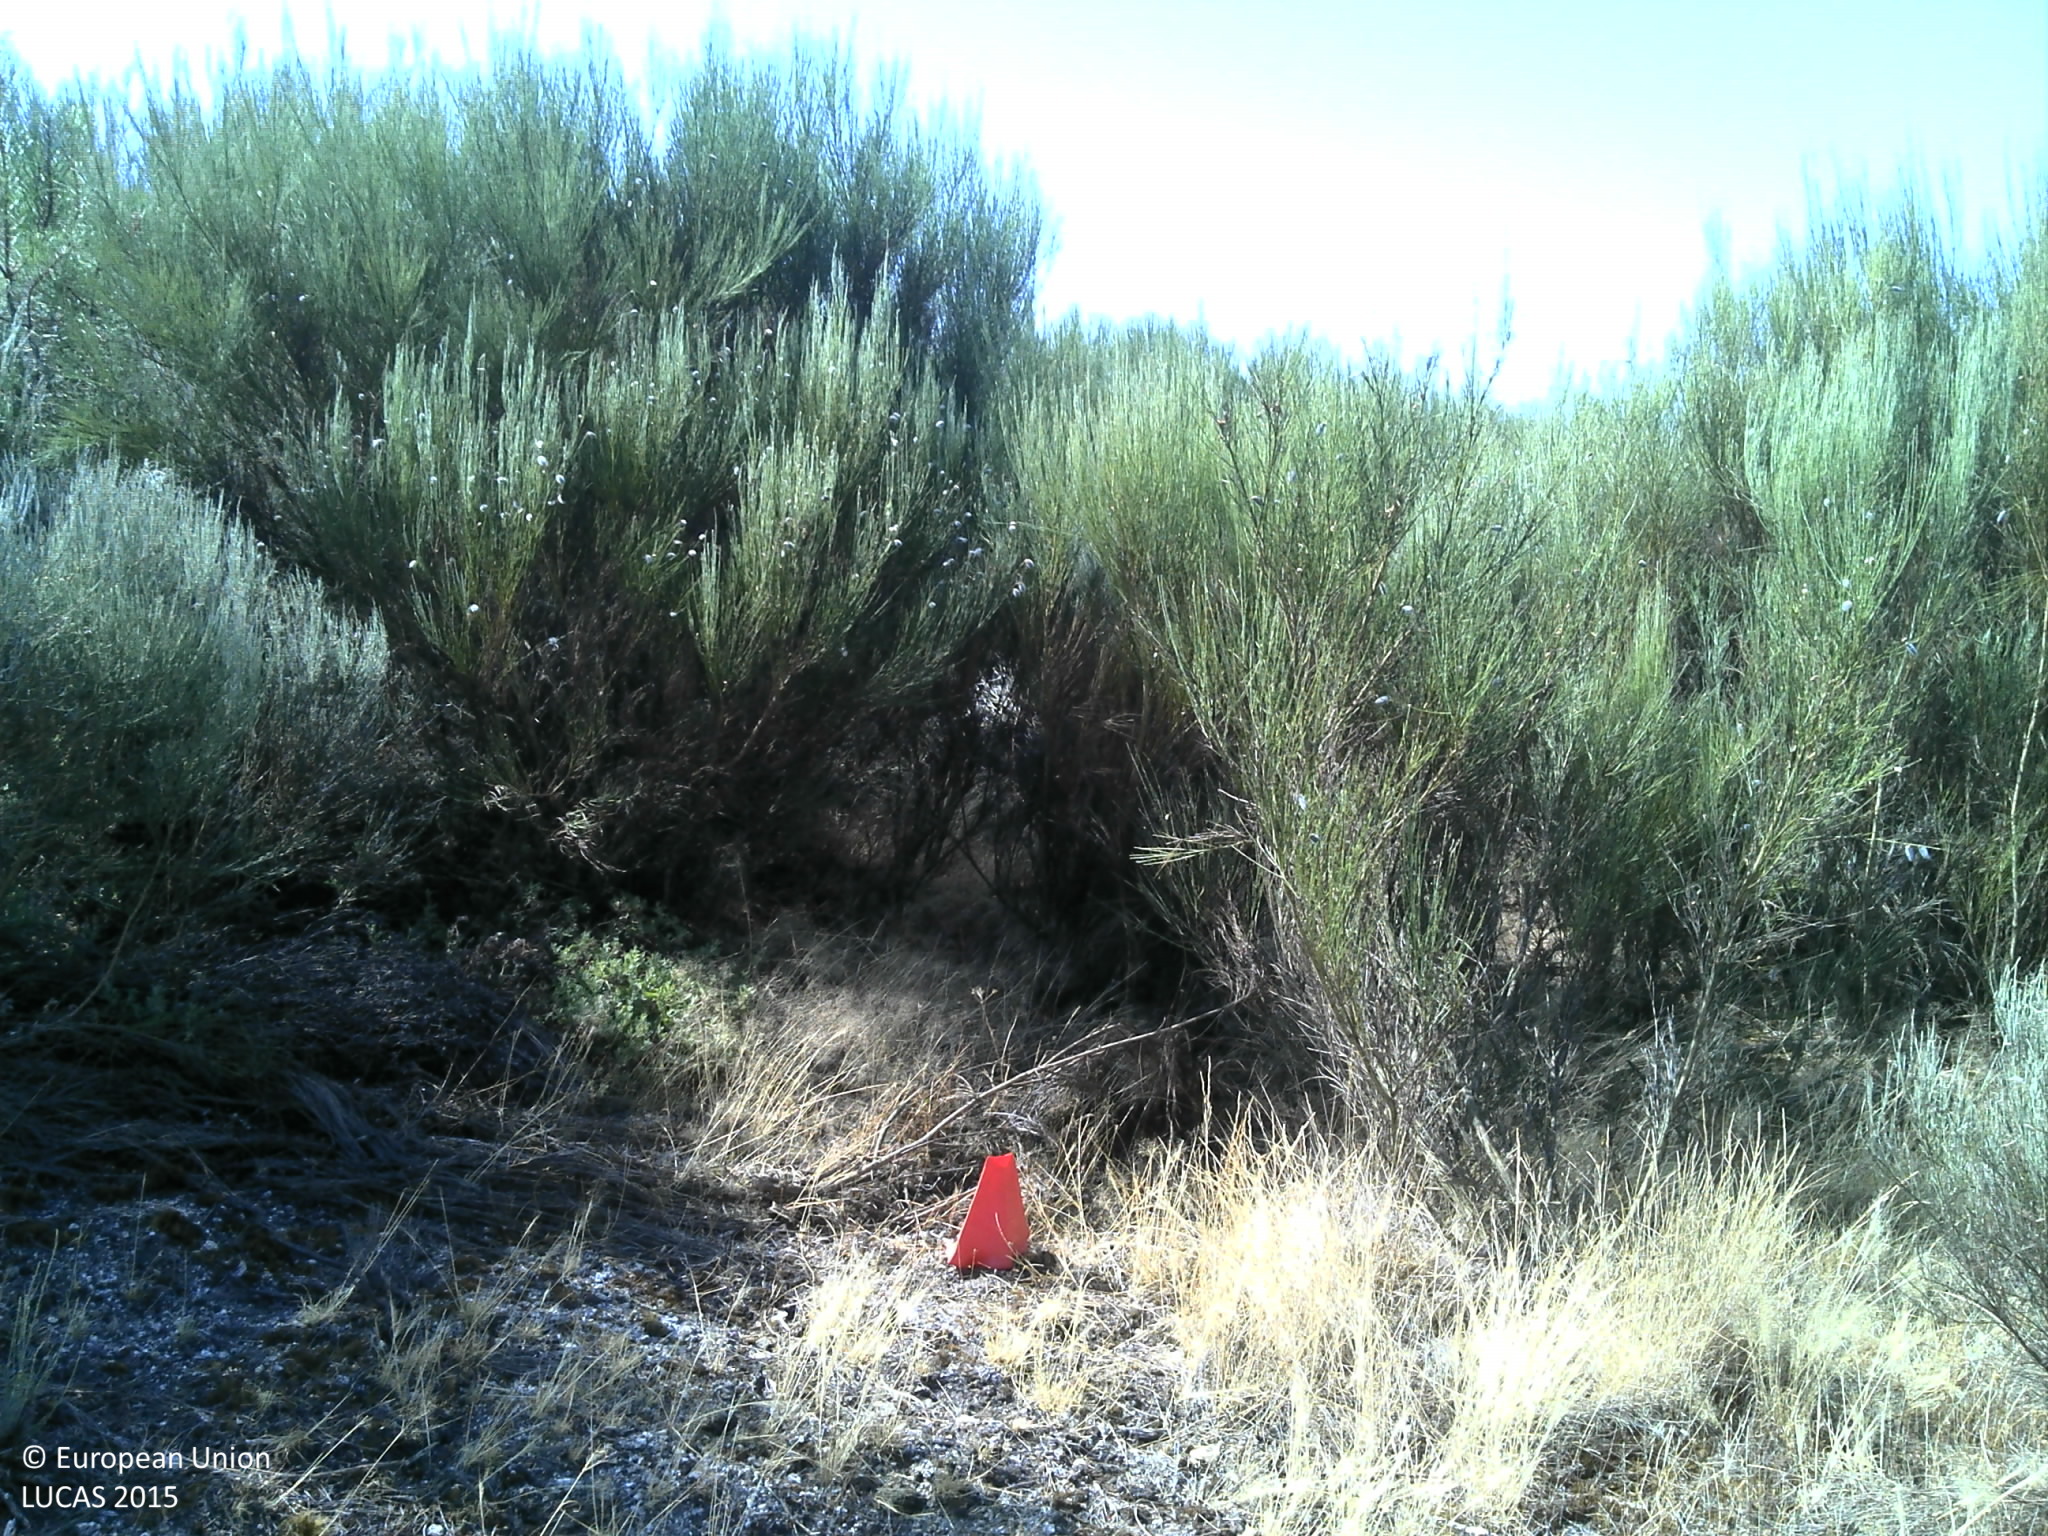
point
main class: Shrubland
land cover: Shrubland with sparse tree cover
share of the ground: 50 - 75 %
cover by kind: shrubs 60 %, herbaceous plants 25 %, coniferous forest trees 5 %, consolidated bare surface 5 %, unconsolidated bare surface 5 %
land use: Semi-natural and natural areas not in use
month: July
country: PT
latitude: 40.8228
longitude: -7.3889
